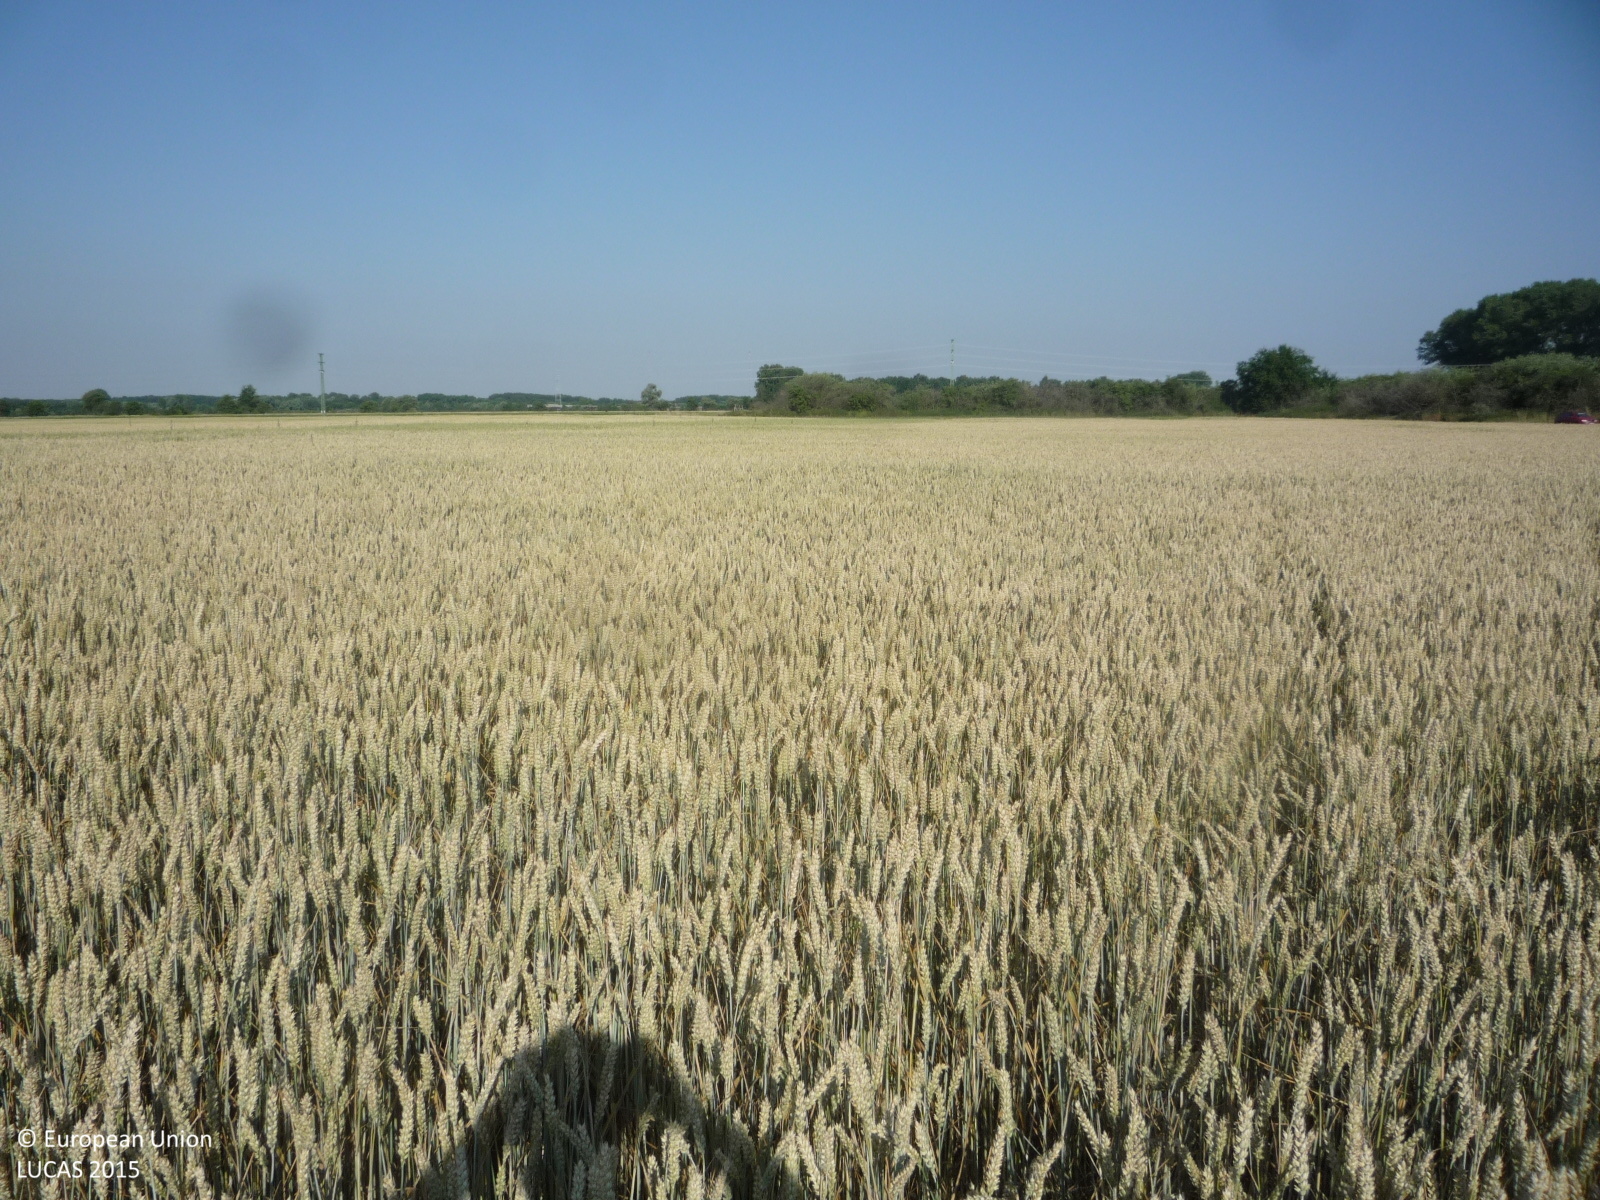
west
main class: Cropland
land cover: Common wheat
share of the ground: > 75 %
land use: Agriculture (excluding fallow land and kitchen gardens)
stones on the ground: < 10 %
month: July
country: CZ
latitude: 50.1380
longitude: 15.1940
